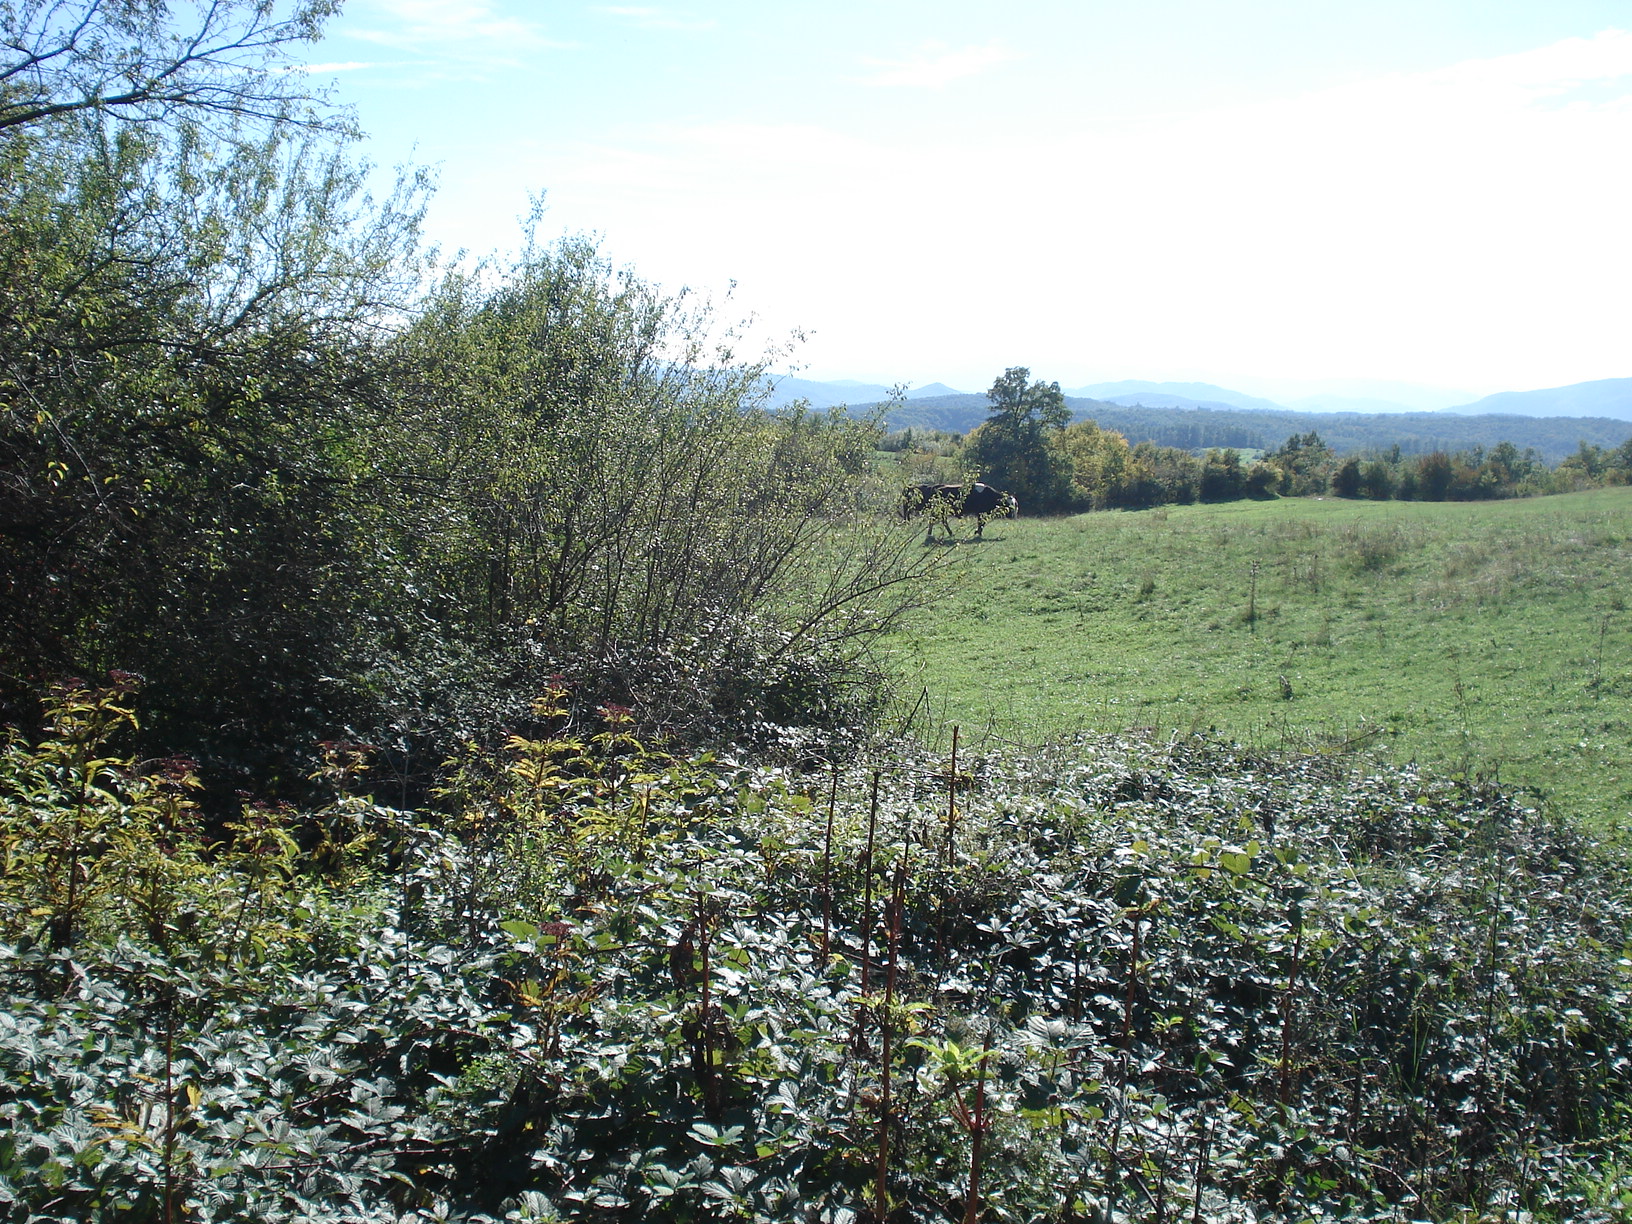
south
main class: Grassland
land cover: Grassland without tree/shrub cover
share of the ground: > 75 %
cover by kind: herbaceous plants 100 %
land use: Agriculture (excluding fallow land and kitchen gardens)
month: October
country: BG
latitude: 42.9572
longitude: 26.0853
